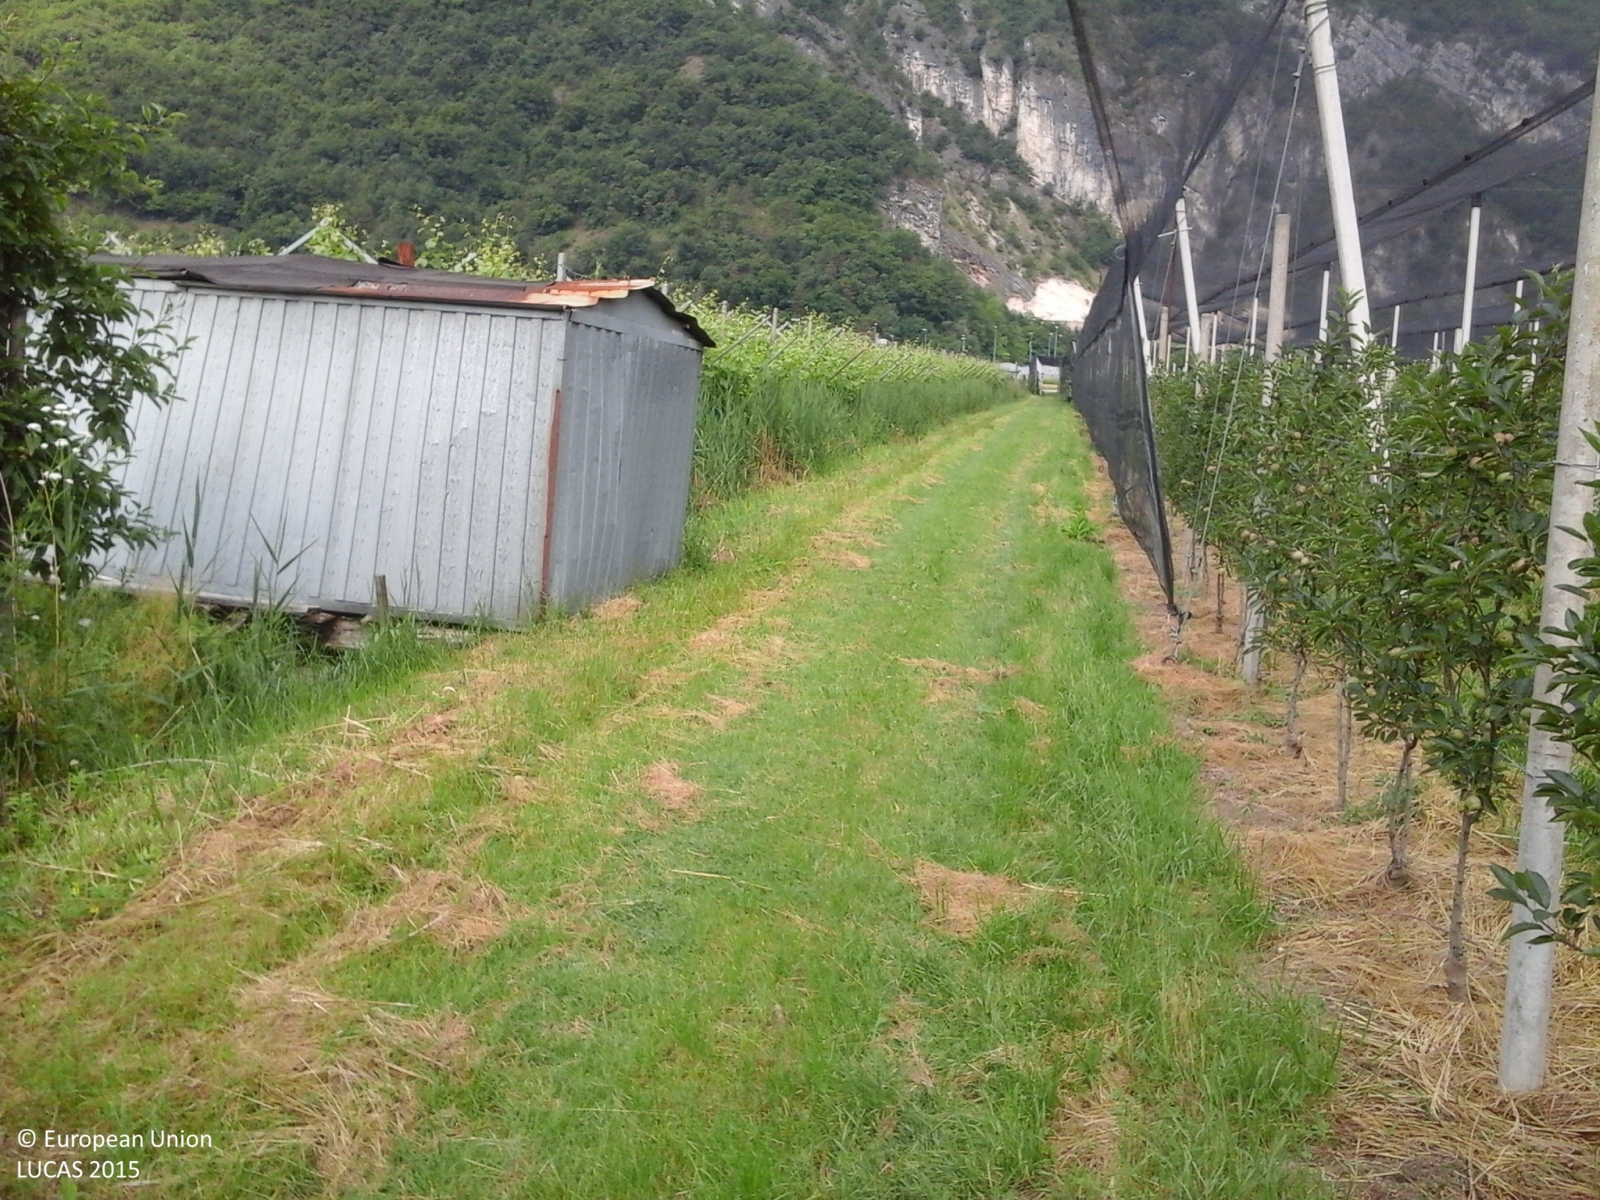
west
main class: Cropland
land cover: Apple fruit
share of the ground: < 10 %
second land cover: Grassland without tree/shrub cover
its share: > 75 %
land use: Agriculture (excluding fallow land and kitchen gardens)
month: June
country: IT
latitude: 45.9673
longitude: 11.0953
